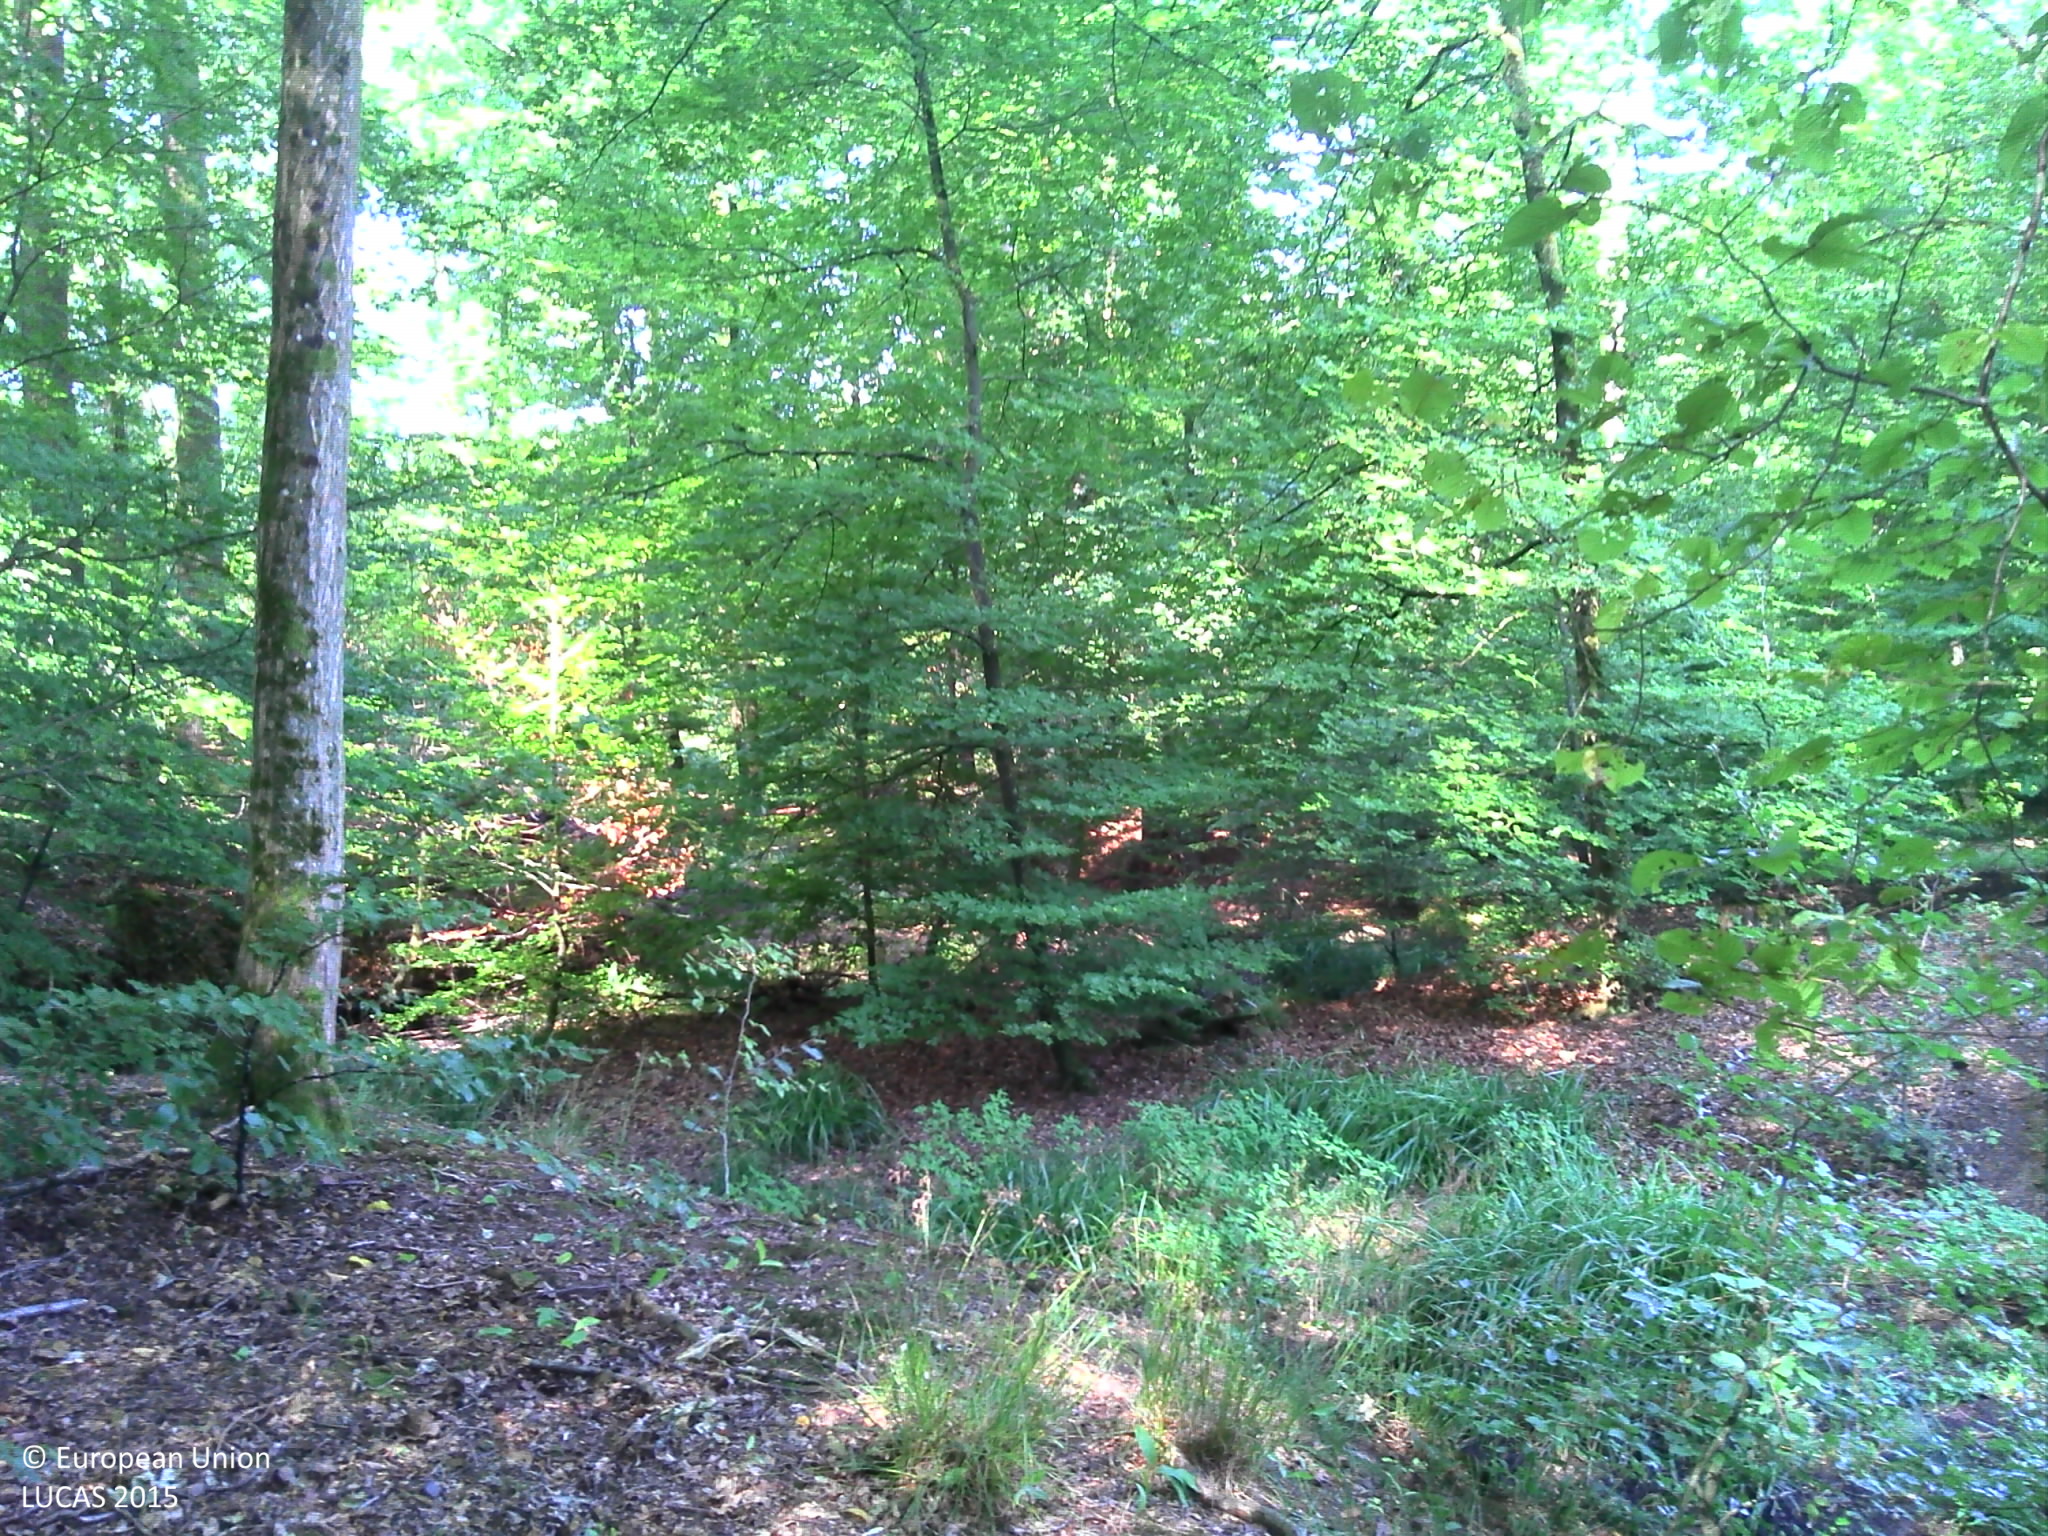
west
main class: Woodland
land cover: Broadleaved woodland
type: beech forest
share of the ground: > 75 %
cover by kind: broadleaved forest trees 95 %, herbaceous plants 5 %
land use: Forestry
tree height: > 5 m
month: August
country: FR
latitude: 48.8708
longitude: 7.9693
